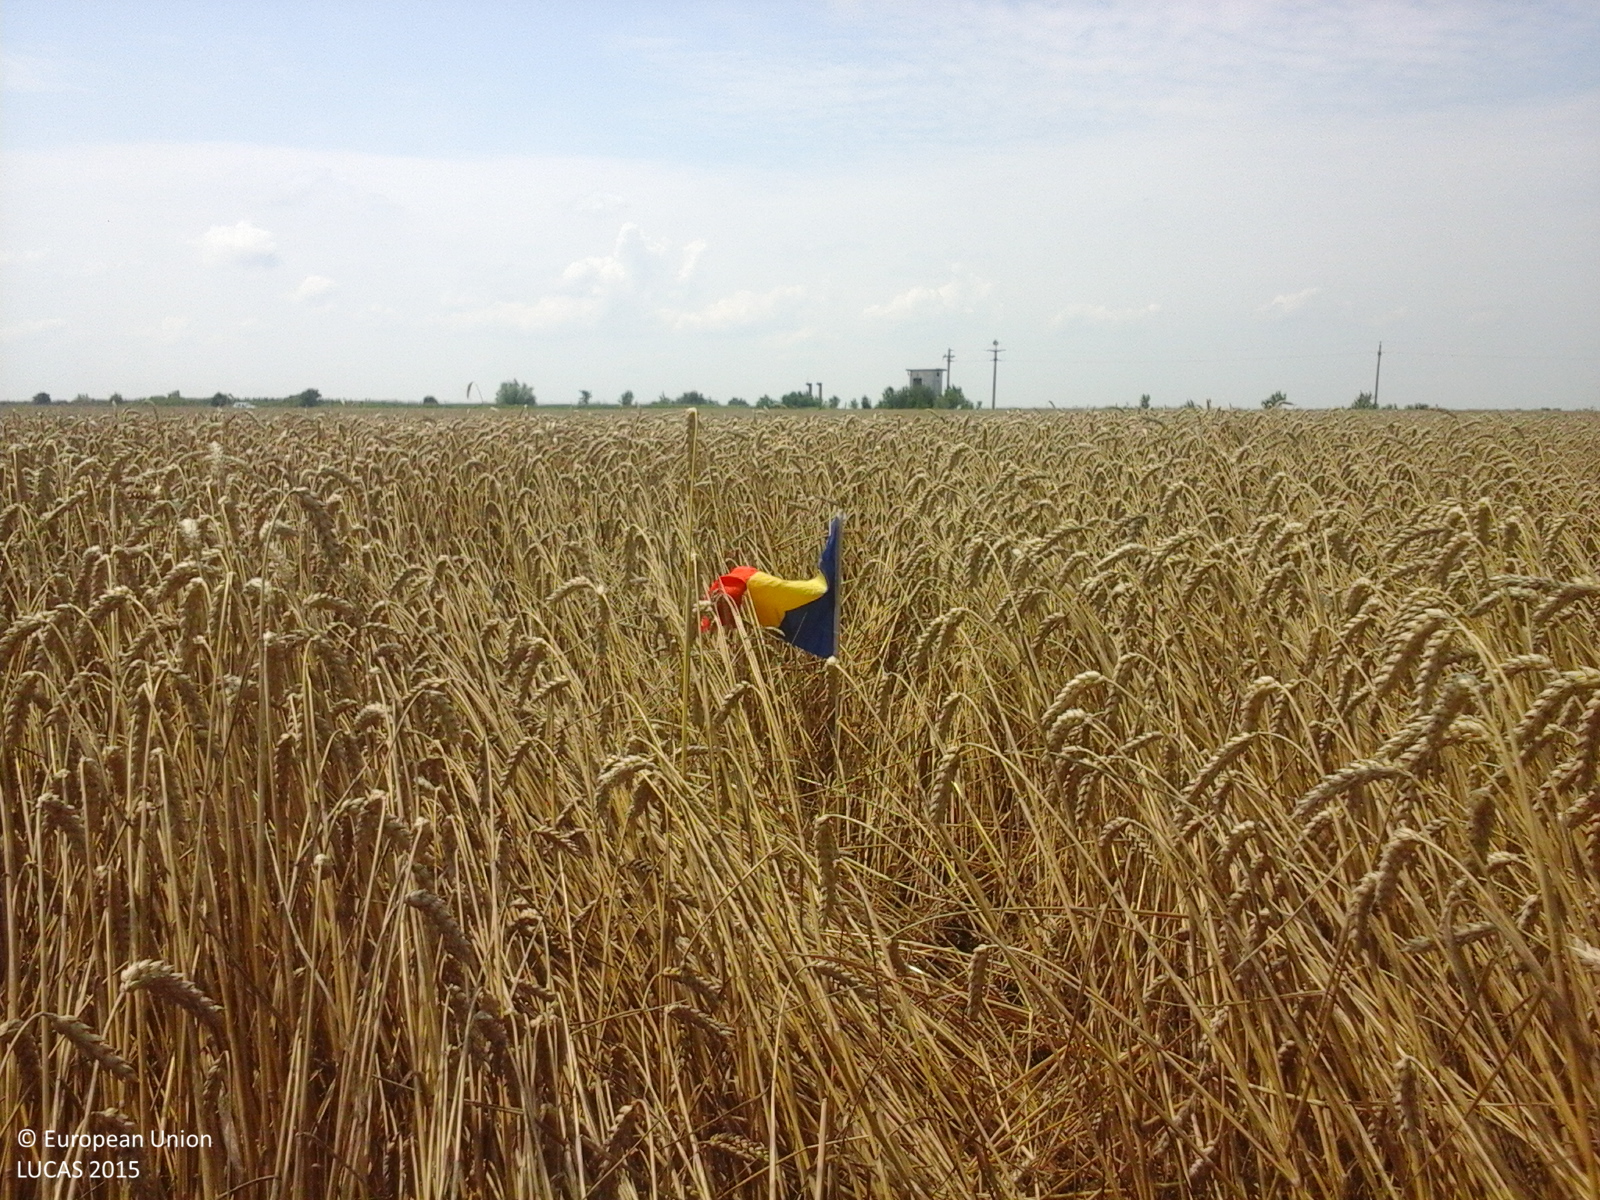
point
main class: Cropland
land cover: Common wheat
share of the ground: > 75 %
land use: Agriculture (excluding fallow land and kitchen gardens)
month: July
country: RO
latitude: 44.0219
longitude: 25.4941
